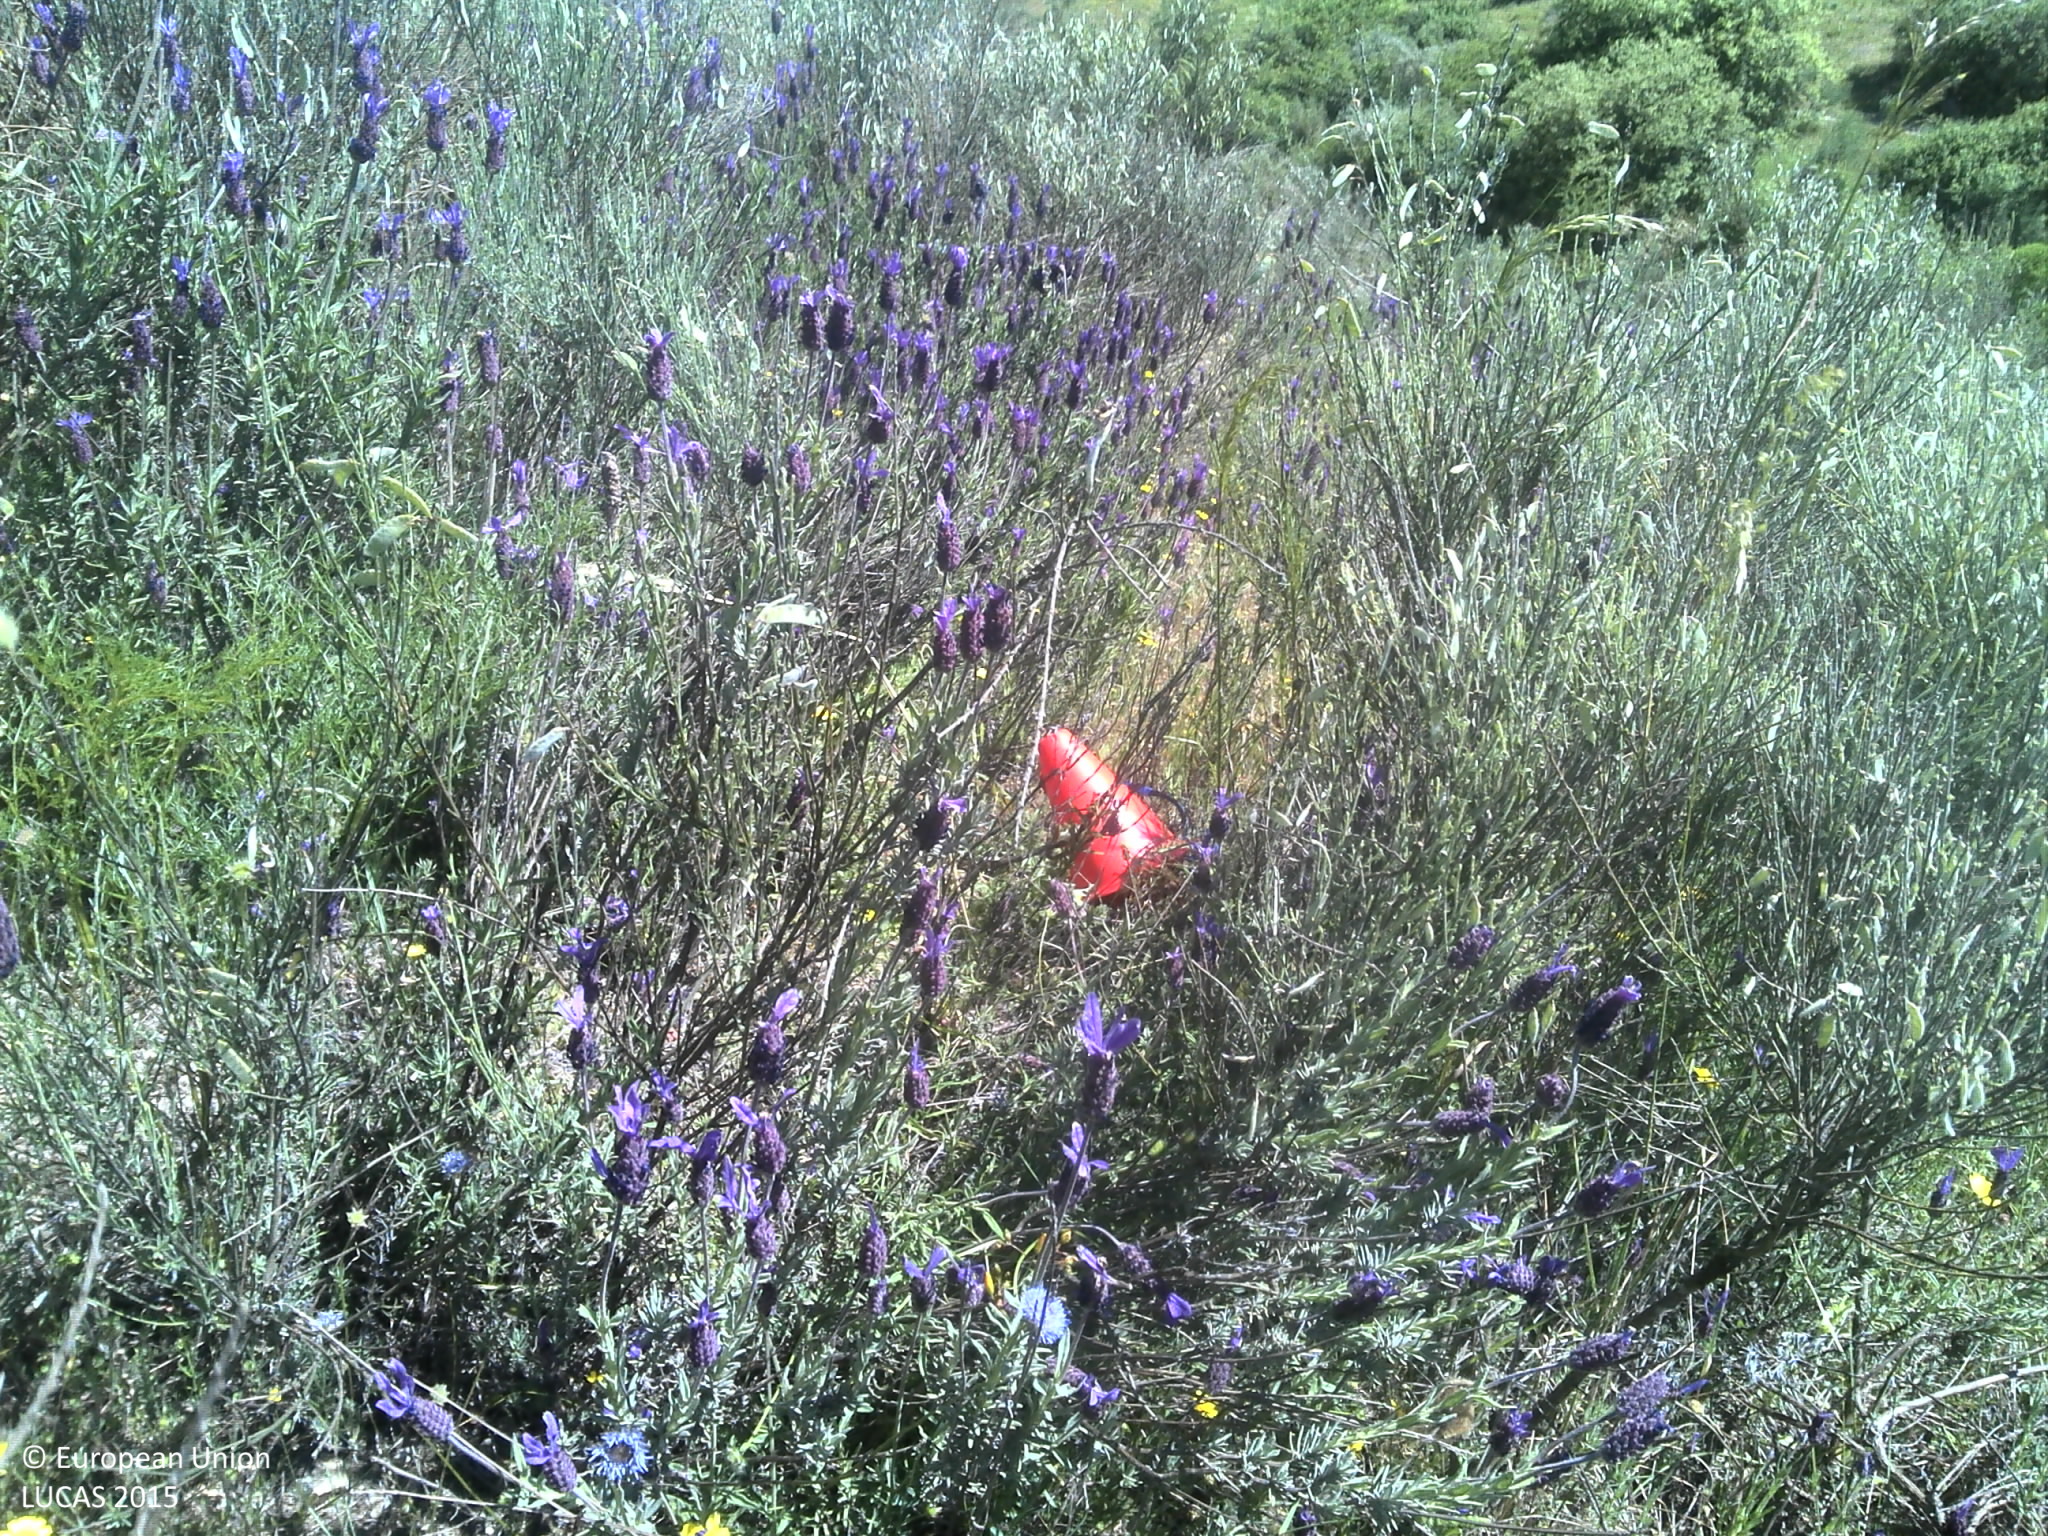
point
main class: Shrubland
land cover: Shrubland without tree cover
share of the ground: 50 - 75 %
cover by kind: shrubs 75 %, herbaceous plants 15 %, unconsolidated bare surface 10 %
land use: Abandoned areas
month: May
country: PT
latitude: 40.6730
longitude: -7.2981
